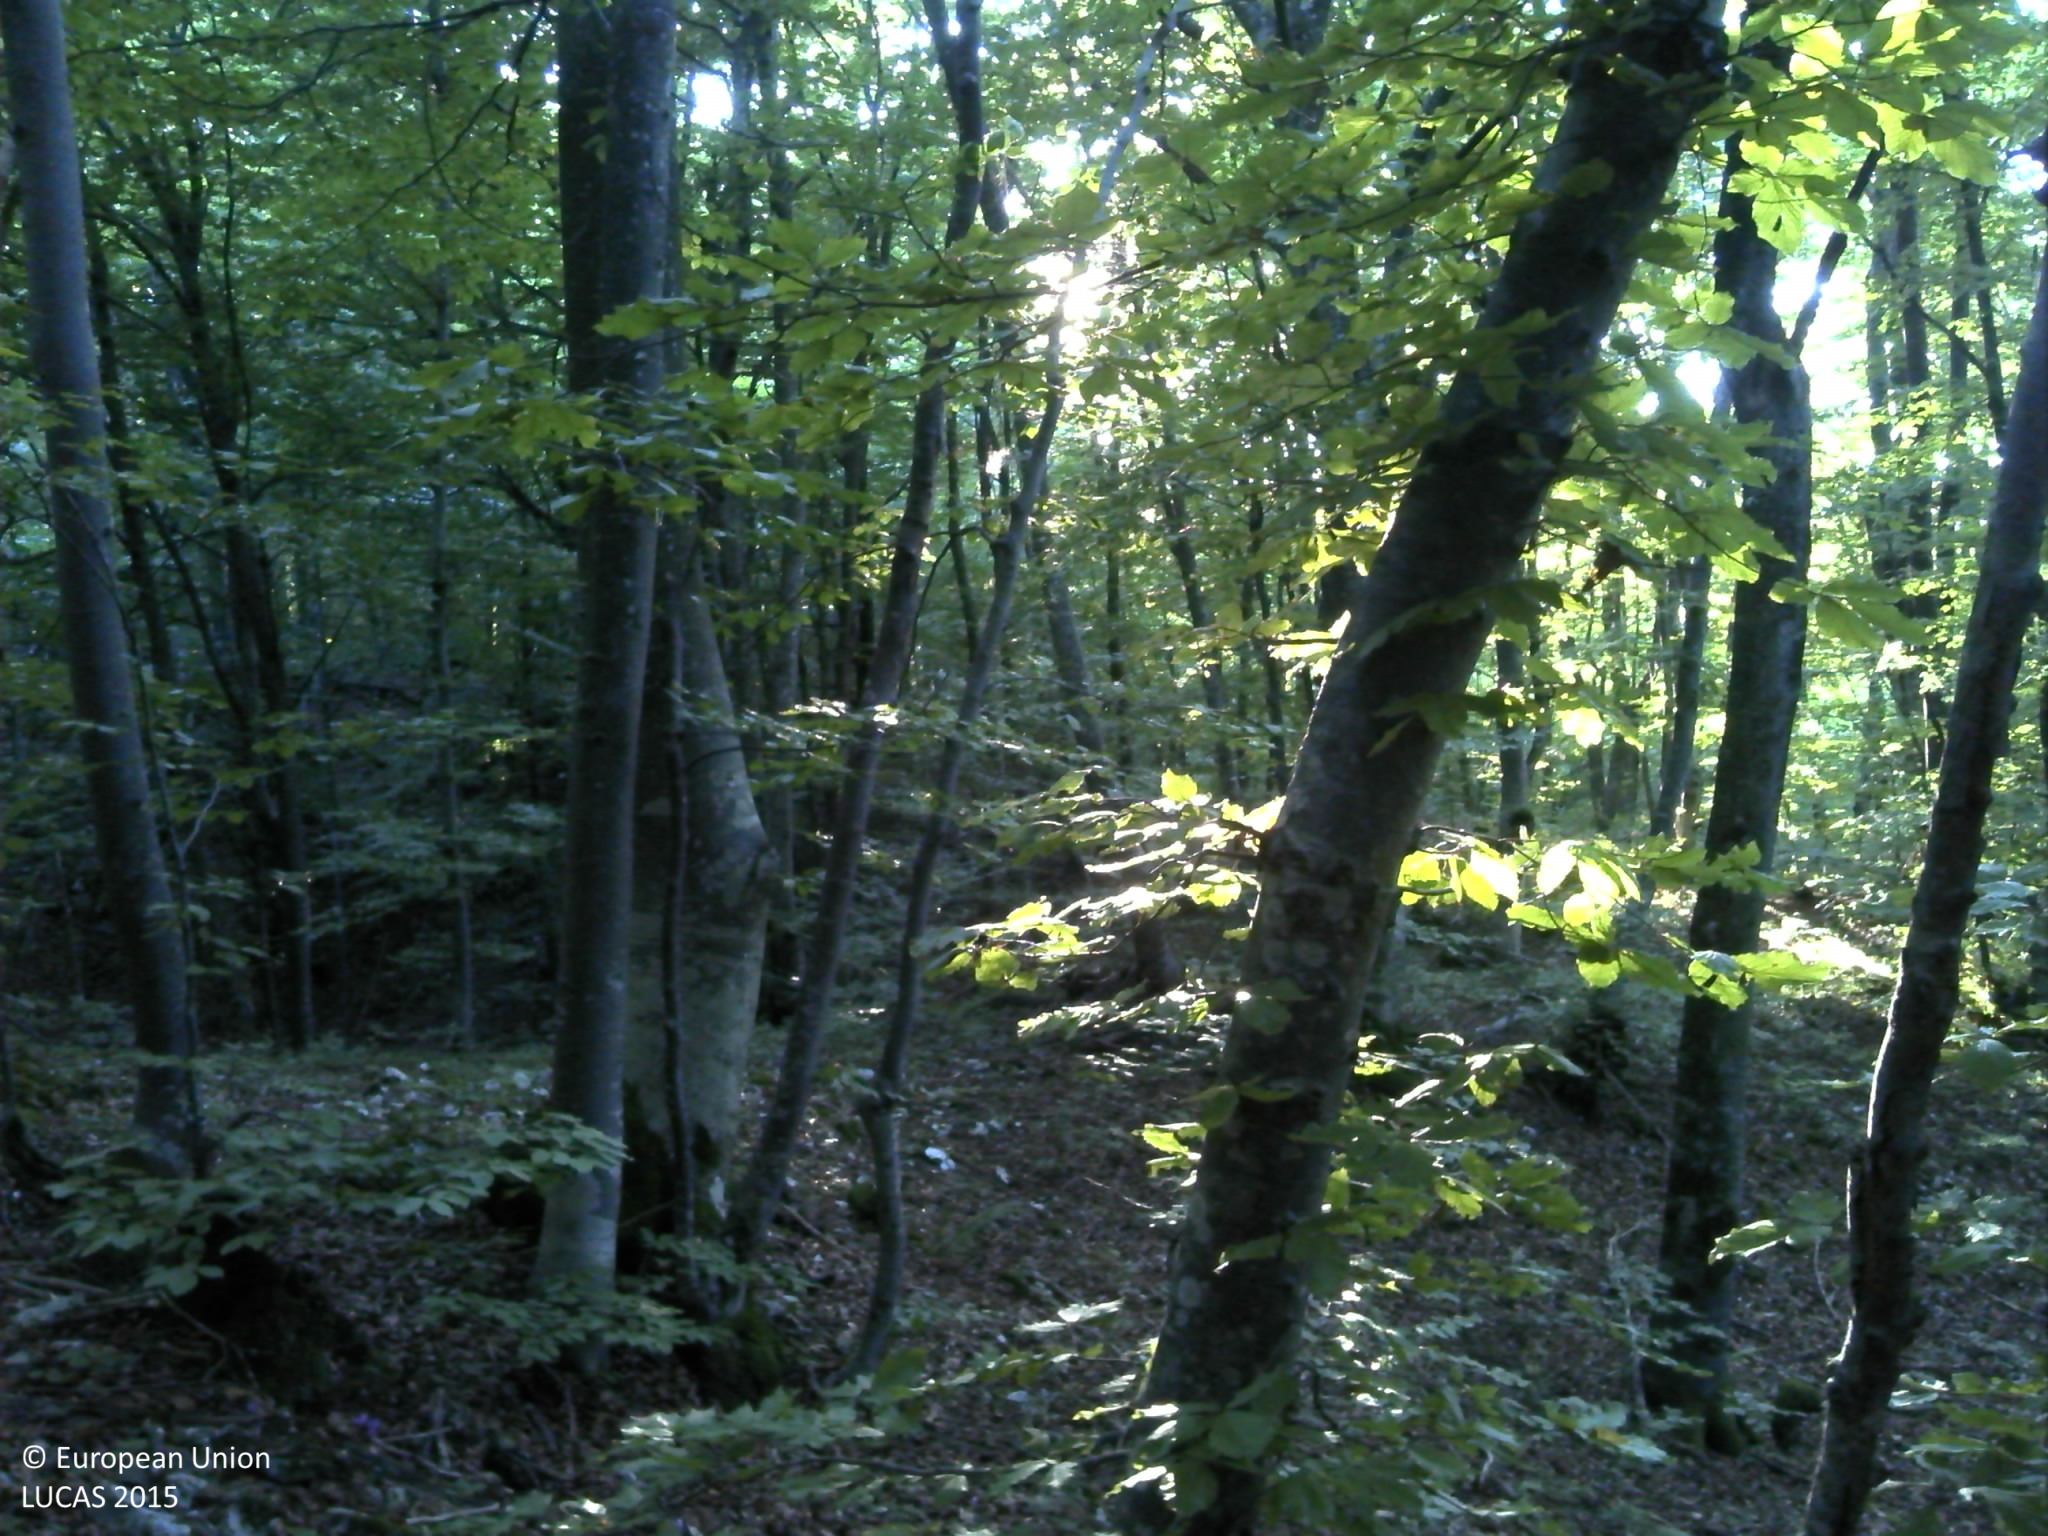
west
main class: Woodland
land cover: Broadleaved woodland
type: beech forest
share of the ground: > 75 %
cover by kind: broadleaved forest trees 90 %, lichens and mosses 5 %, consolidated bare surface 5 %
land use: Forestry
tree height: > 5 m
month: August
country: HR
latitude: 44.9012
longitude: 15.6556
